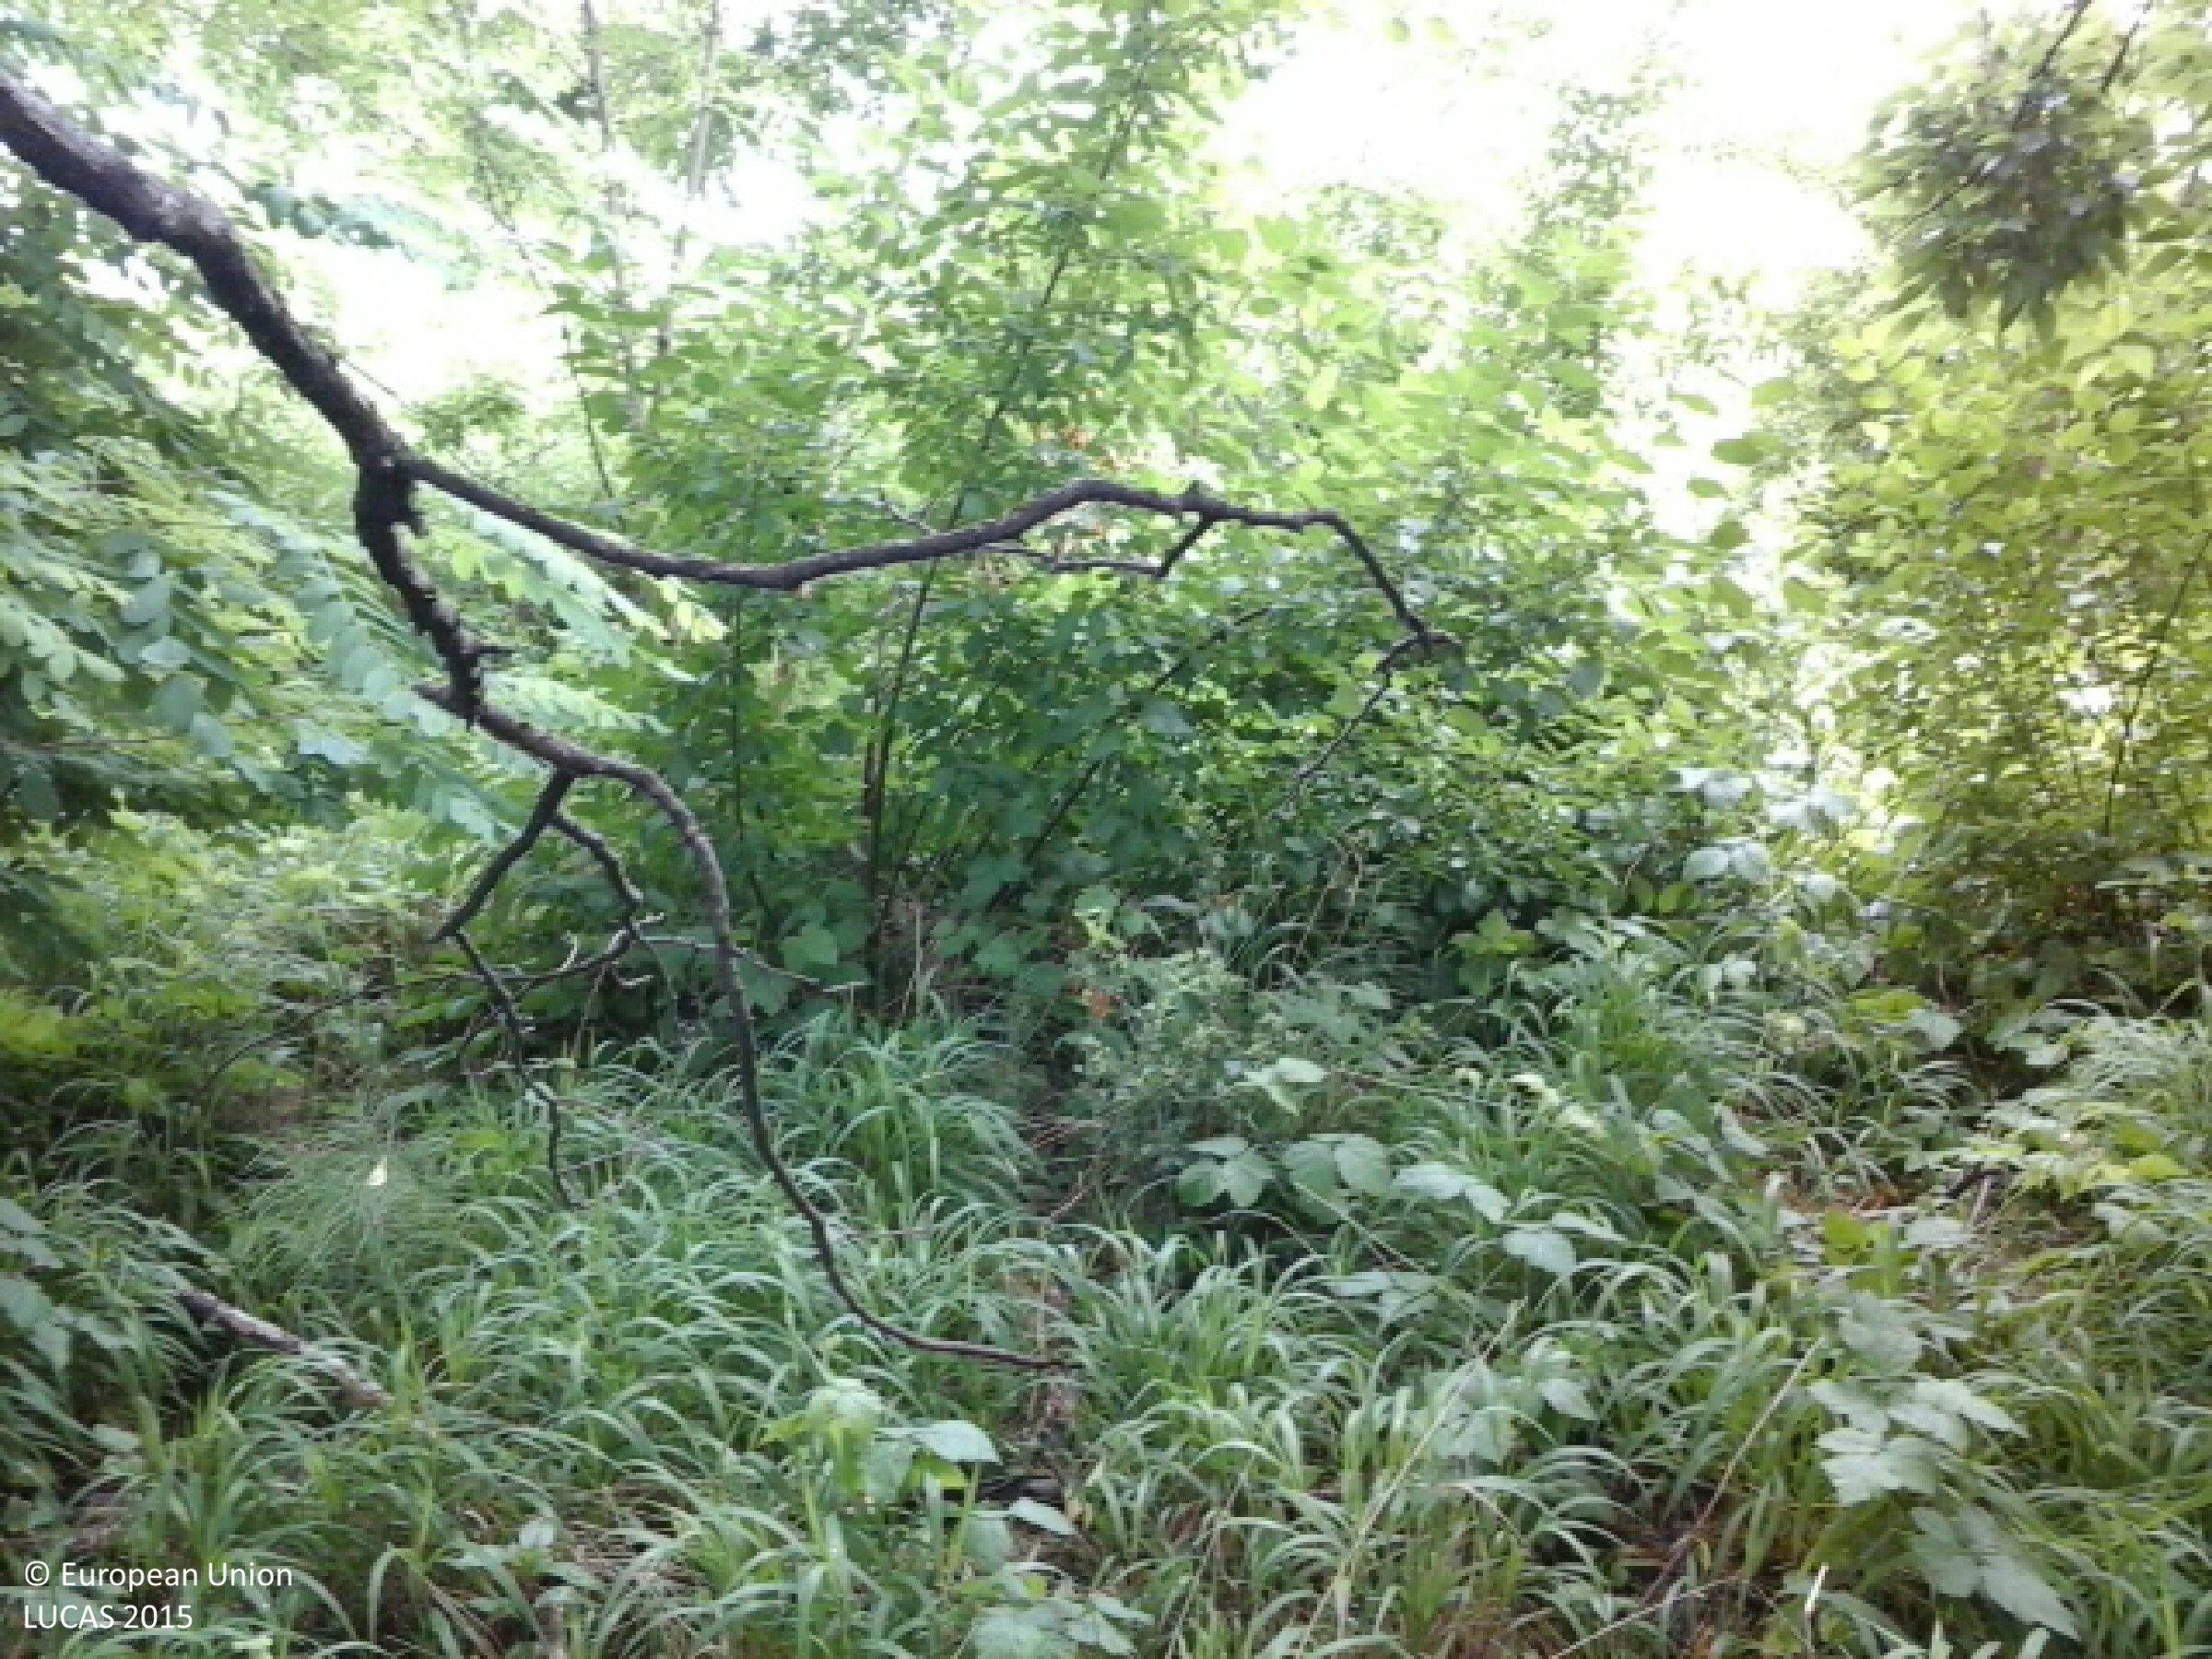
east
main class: Woodland
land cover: Broadleaved woodland
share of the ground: > 75 %
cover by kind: broadleaved forest trees 90 %, shrubs 5 %, herbaceous plants 5 %
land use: Forestry
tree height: > 5 m
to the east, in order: Broadleaved woodland; Maize; Grass margins; Ditches and canals; Tracks; Grassland without tree/shrub cover
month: June
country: HU
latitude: 47.9341
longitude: 21.7879
